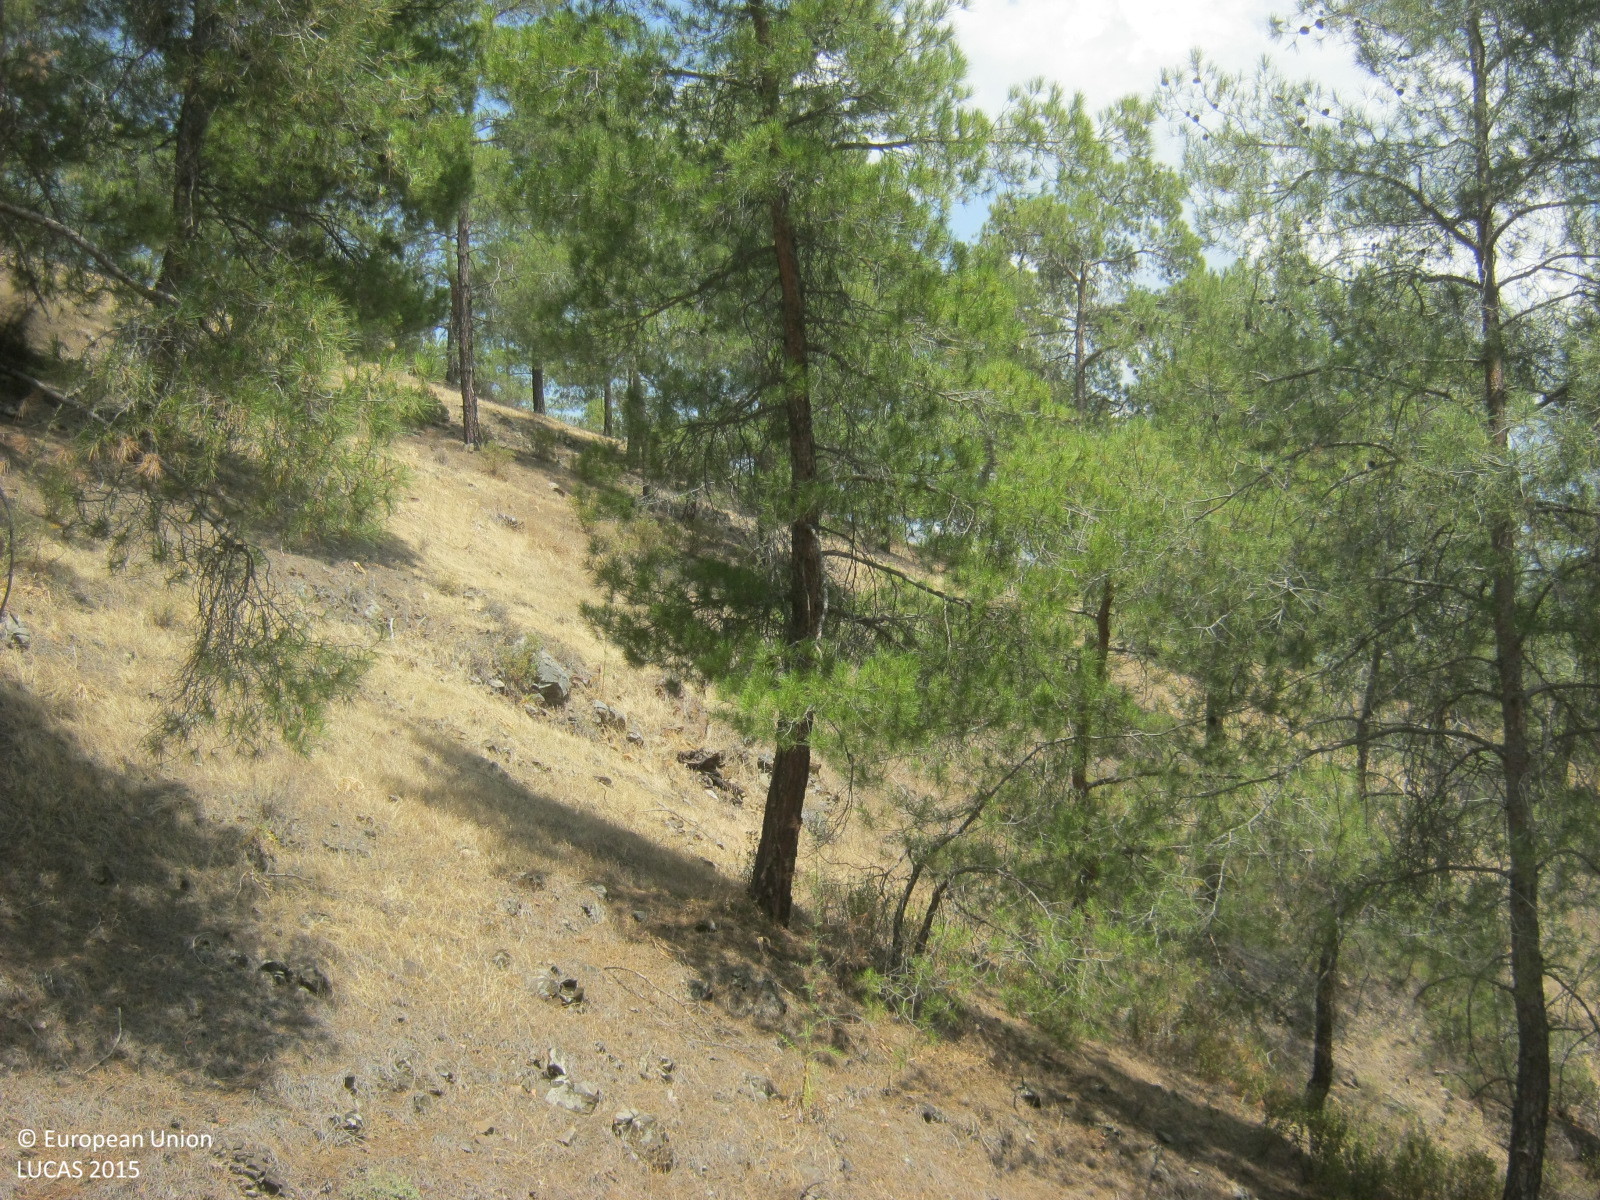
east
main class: Woodland
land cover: Pine dominated coniferous woodland
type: coniferous forest of the mediterranean region
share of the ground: 50 - 75 %
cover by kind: coniferous forest trees 60 %, herbaceous plants 20 %, shrubs 10 %, unconsolidated bare surface 10 %
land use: Forestry
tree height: > 5 m
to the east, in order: Pine dominated coniferous woodland
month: June
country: CY
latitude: 34.9968
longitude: 33.0868
